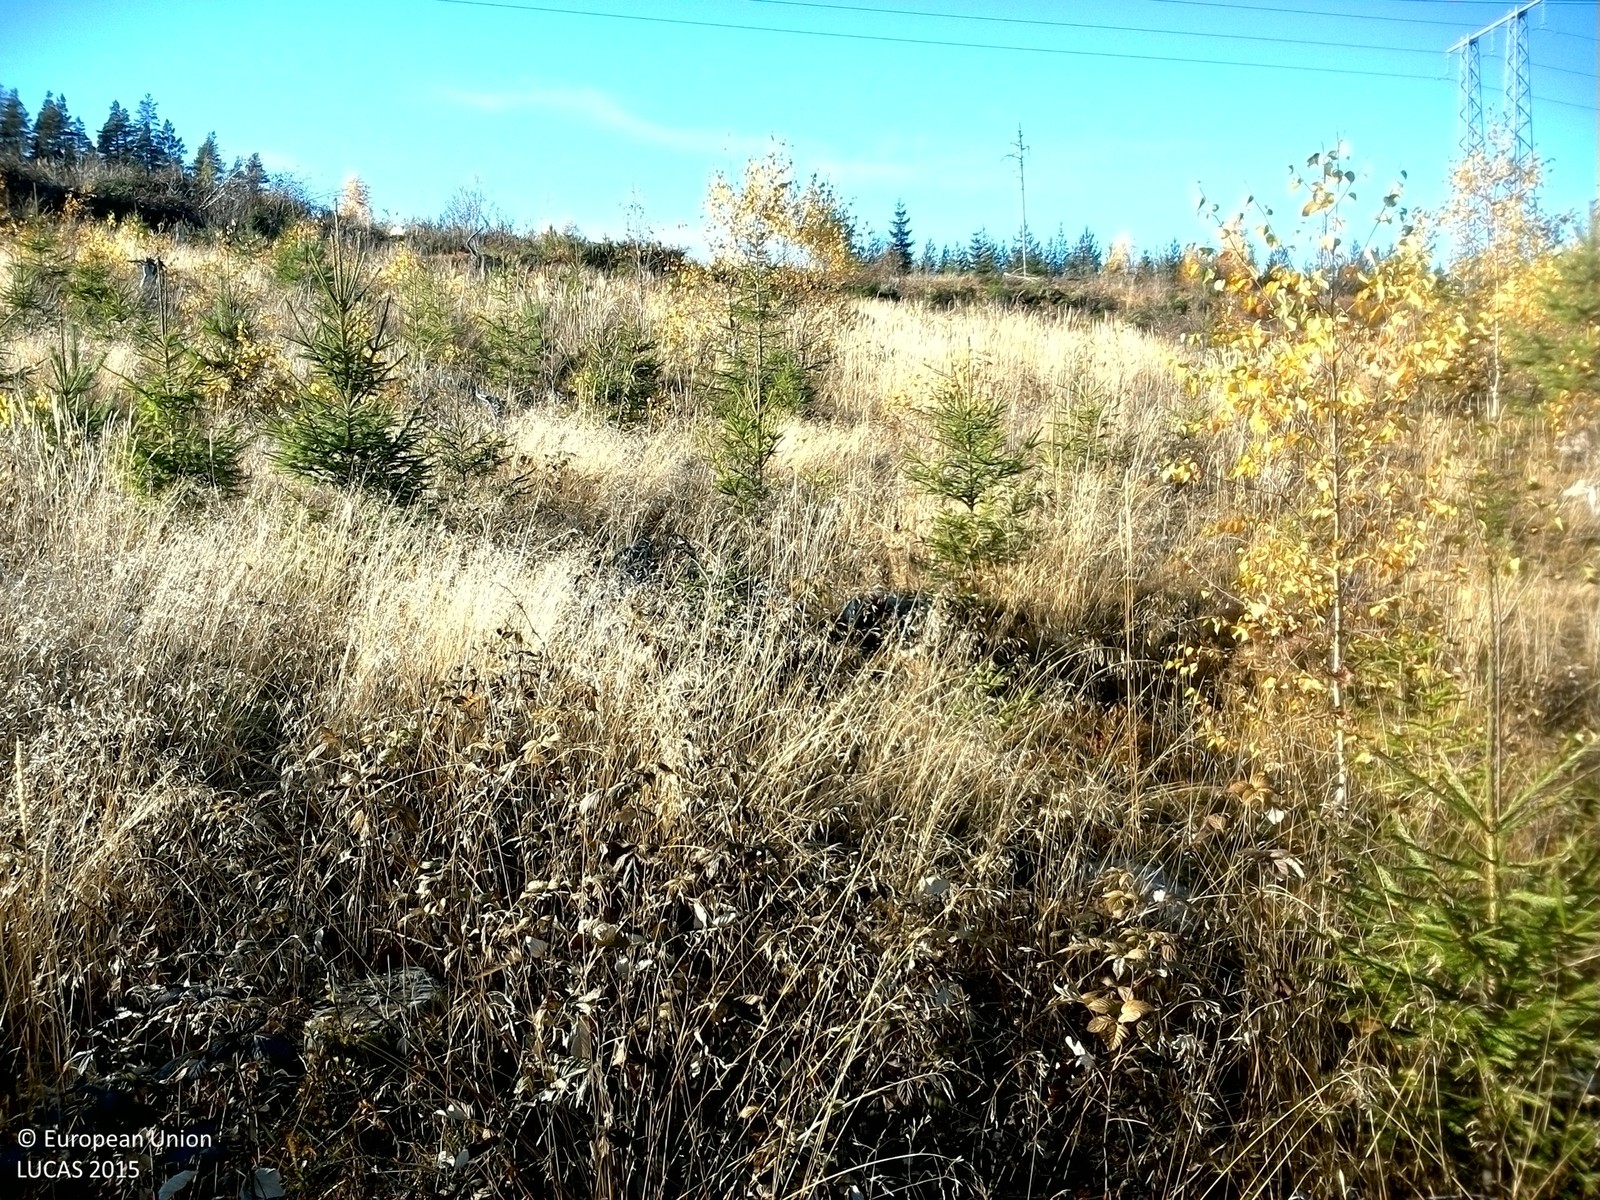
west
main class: Woodland
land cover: Spruce dominated mixed woodland
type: boreal forest
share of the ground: 25 - 50 %
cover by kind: coniferous forest trees 25 %, broadleaved forest trees 25 %, shrubs 25 %, herbaceous plants 25 %
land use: Forestry
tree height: < 5 m
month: October
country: SE
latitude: 61.1966
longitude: 14.3215
